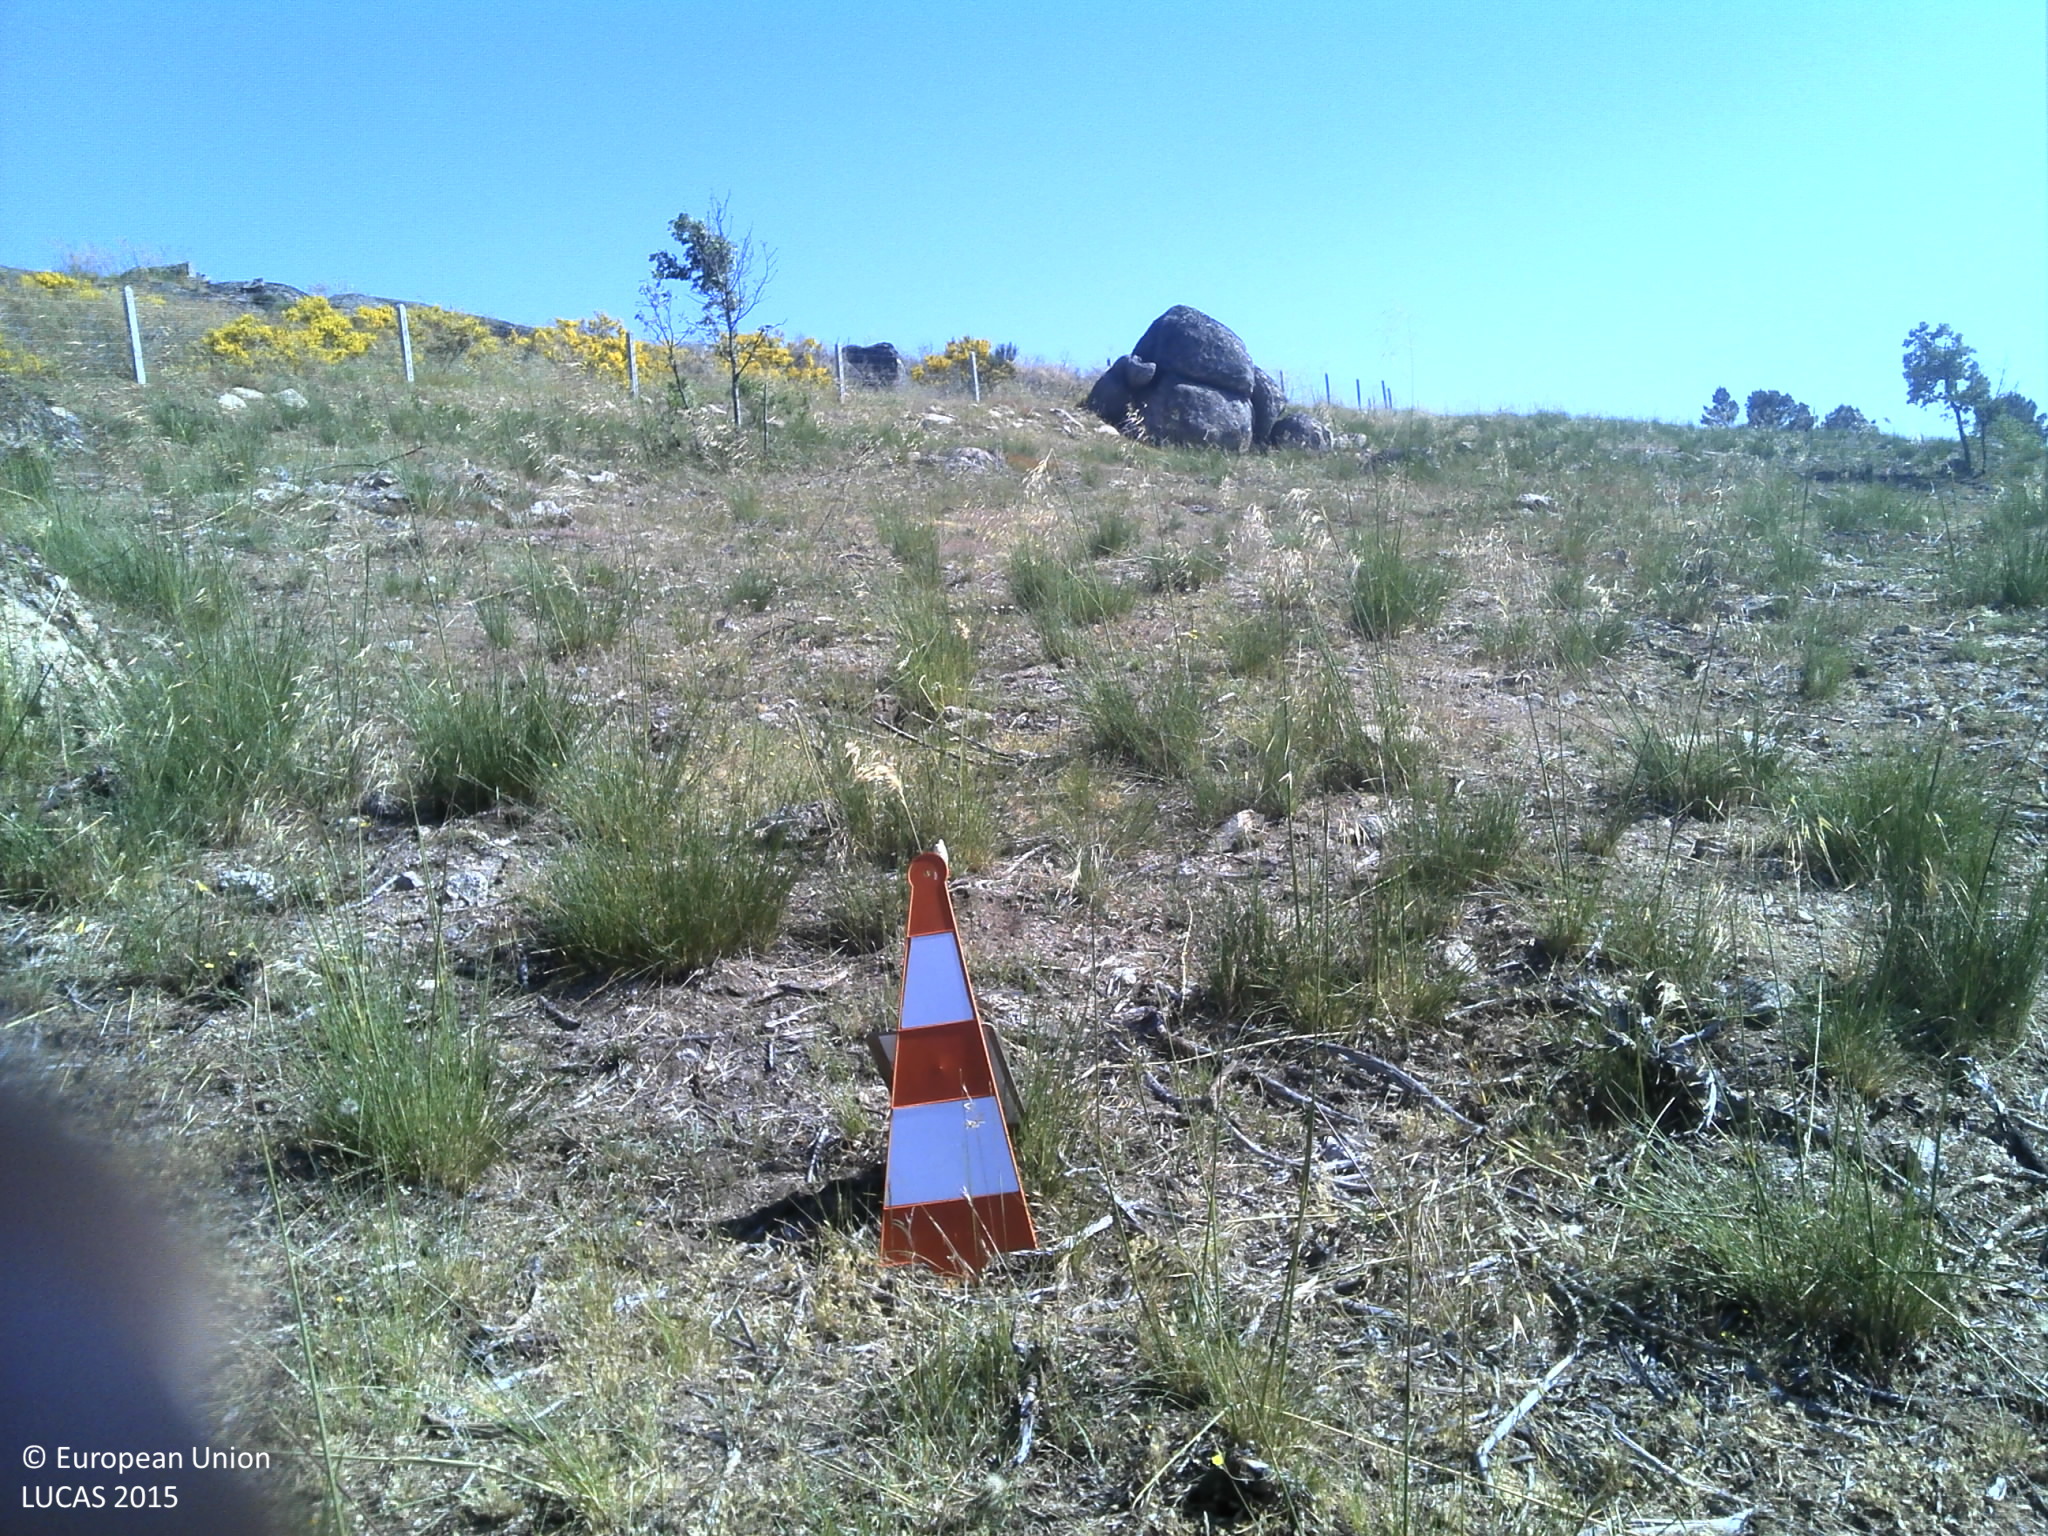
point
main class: Grassland
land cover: Grassland without tree/shrub cover
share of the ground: 10 - 25 %
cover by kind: unconsolidated bare surface 65 %, herbaceous plants 25 %, shrubs 5 %
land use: Agriculture (excluding fallow land and kitchen gardens)
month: May
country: PT
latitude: 40.5459
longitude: -7.2869
